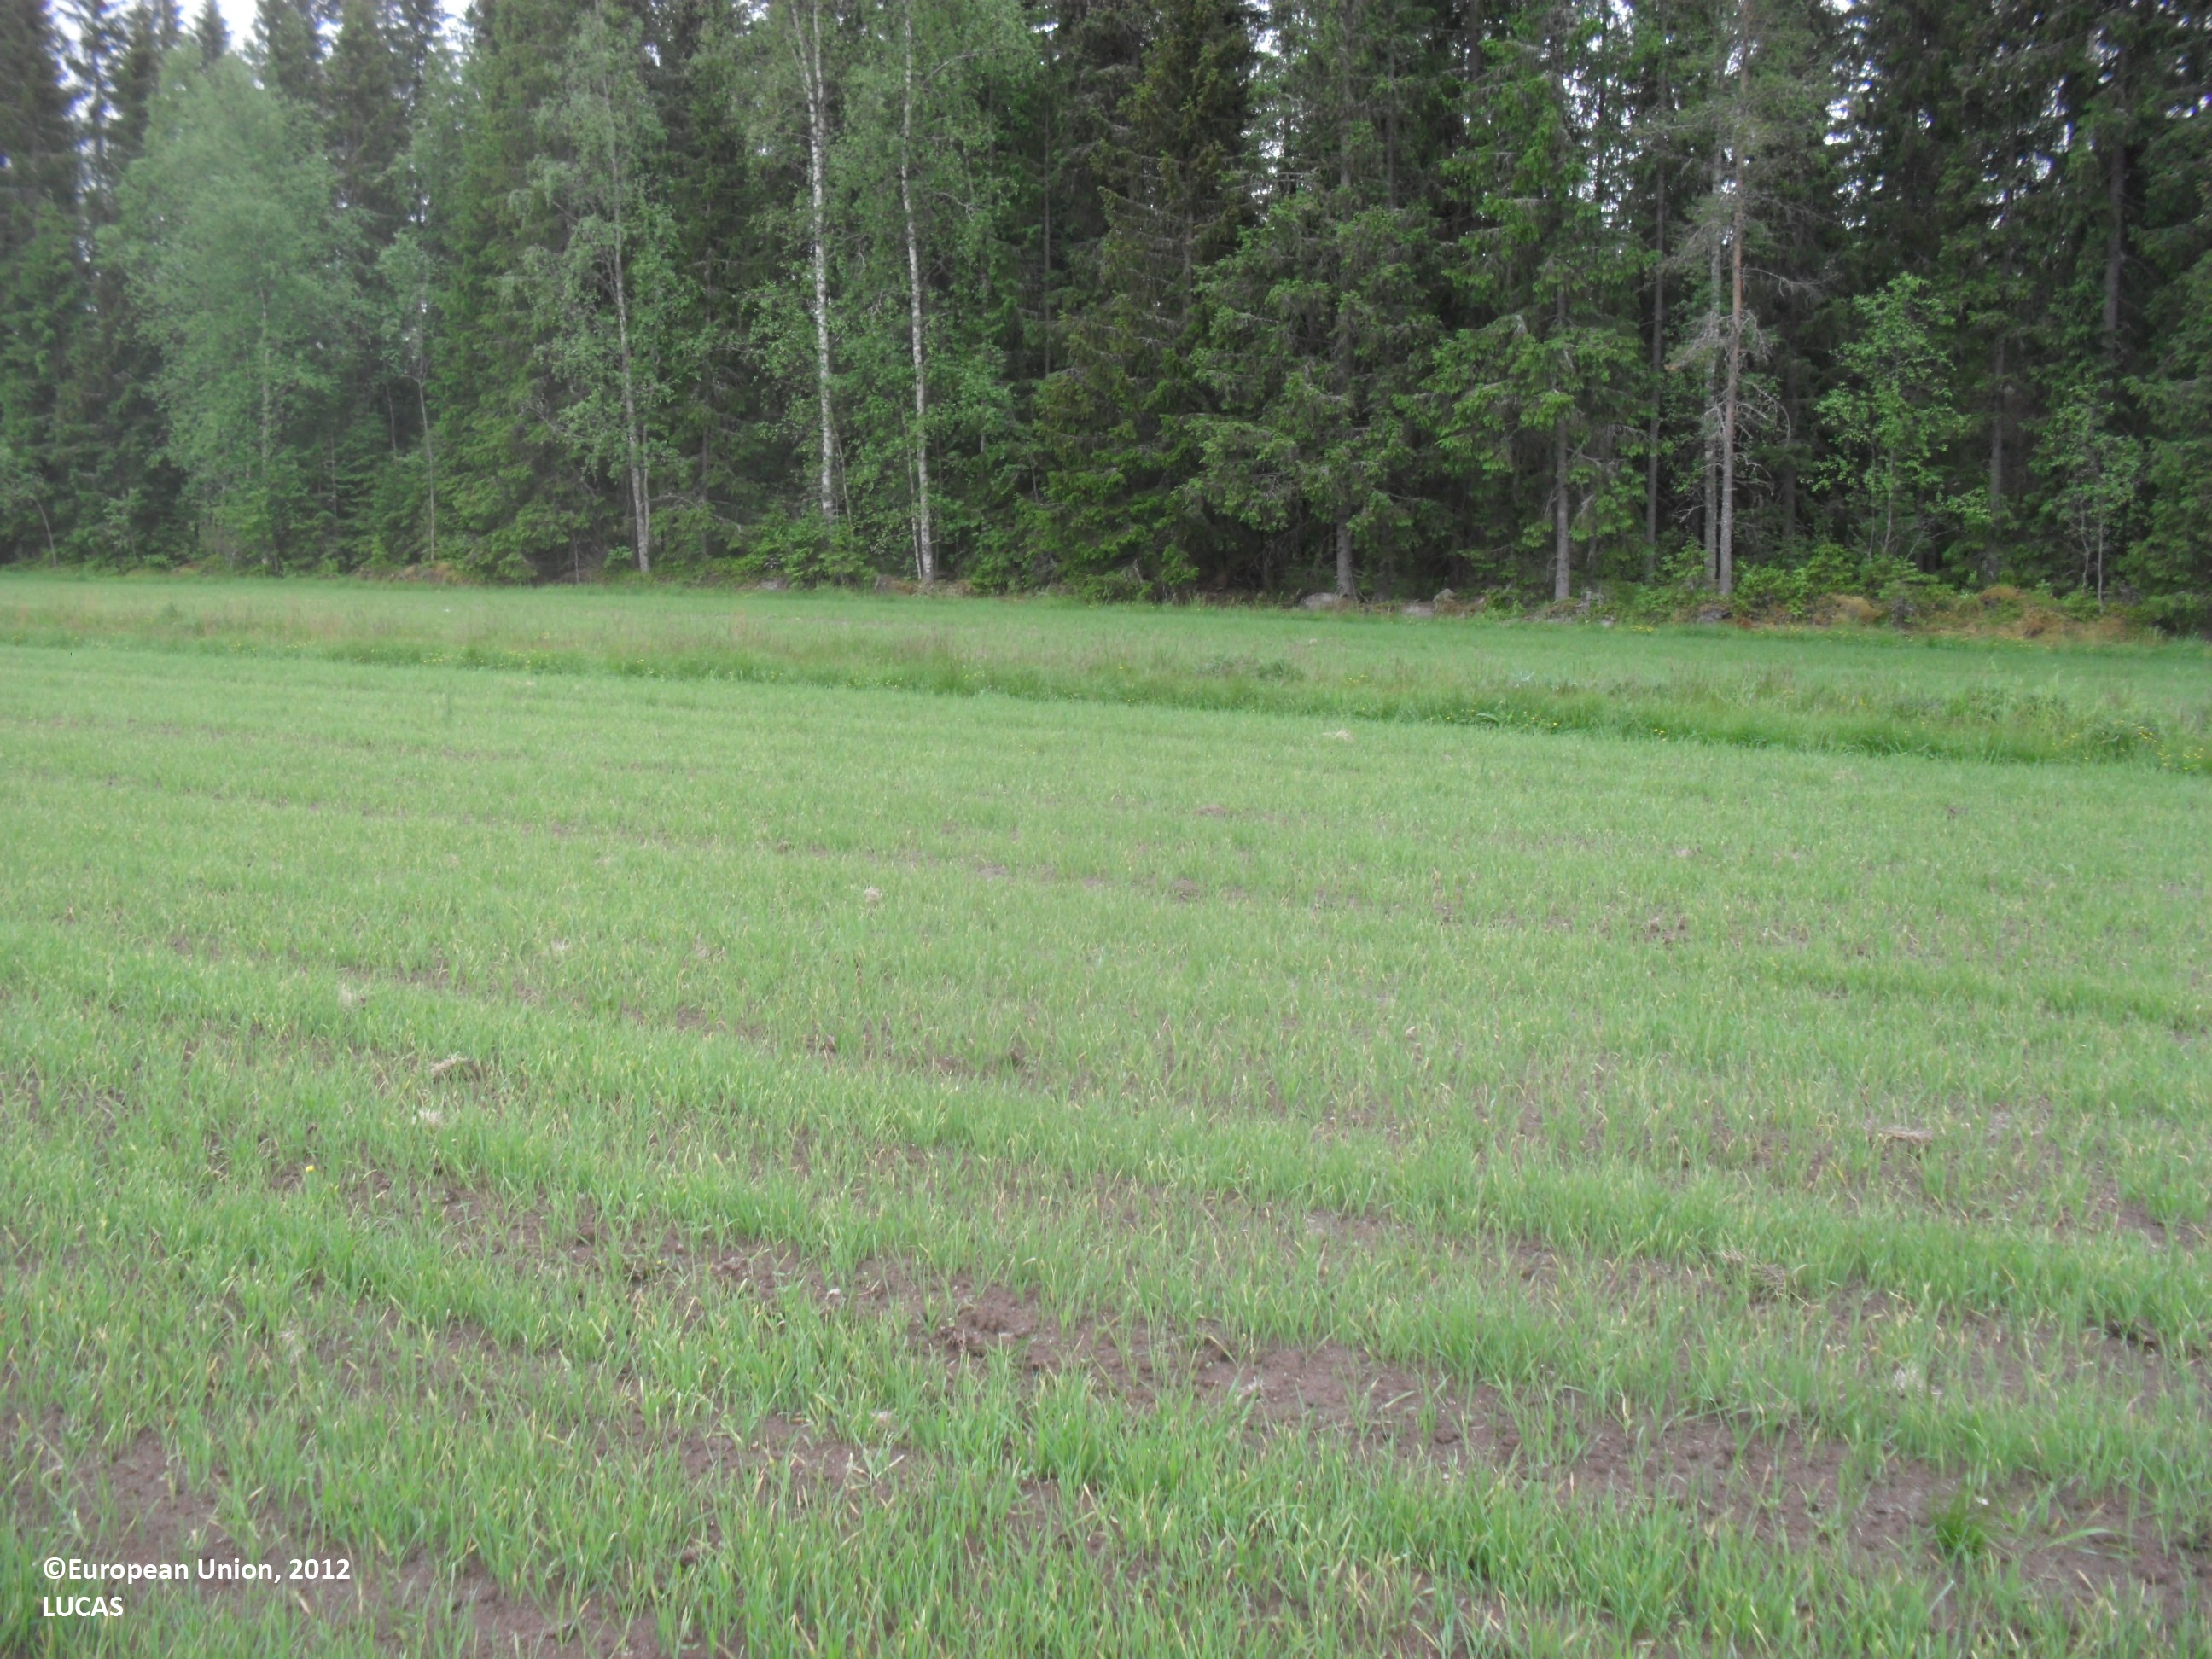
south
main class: Cropland
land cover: Barley
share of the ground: 10 - 25 %
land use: Agriculture (excluding fallow land and kitchen gardens)
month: June
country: FI
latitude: 63.4898
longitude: 23.0472
